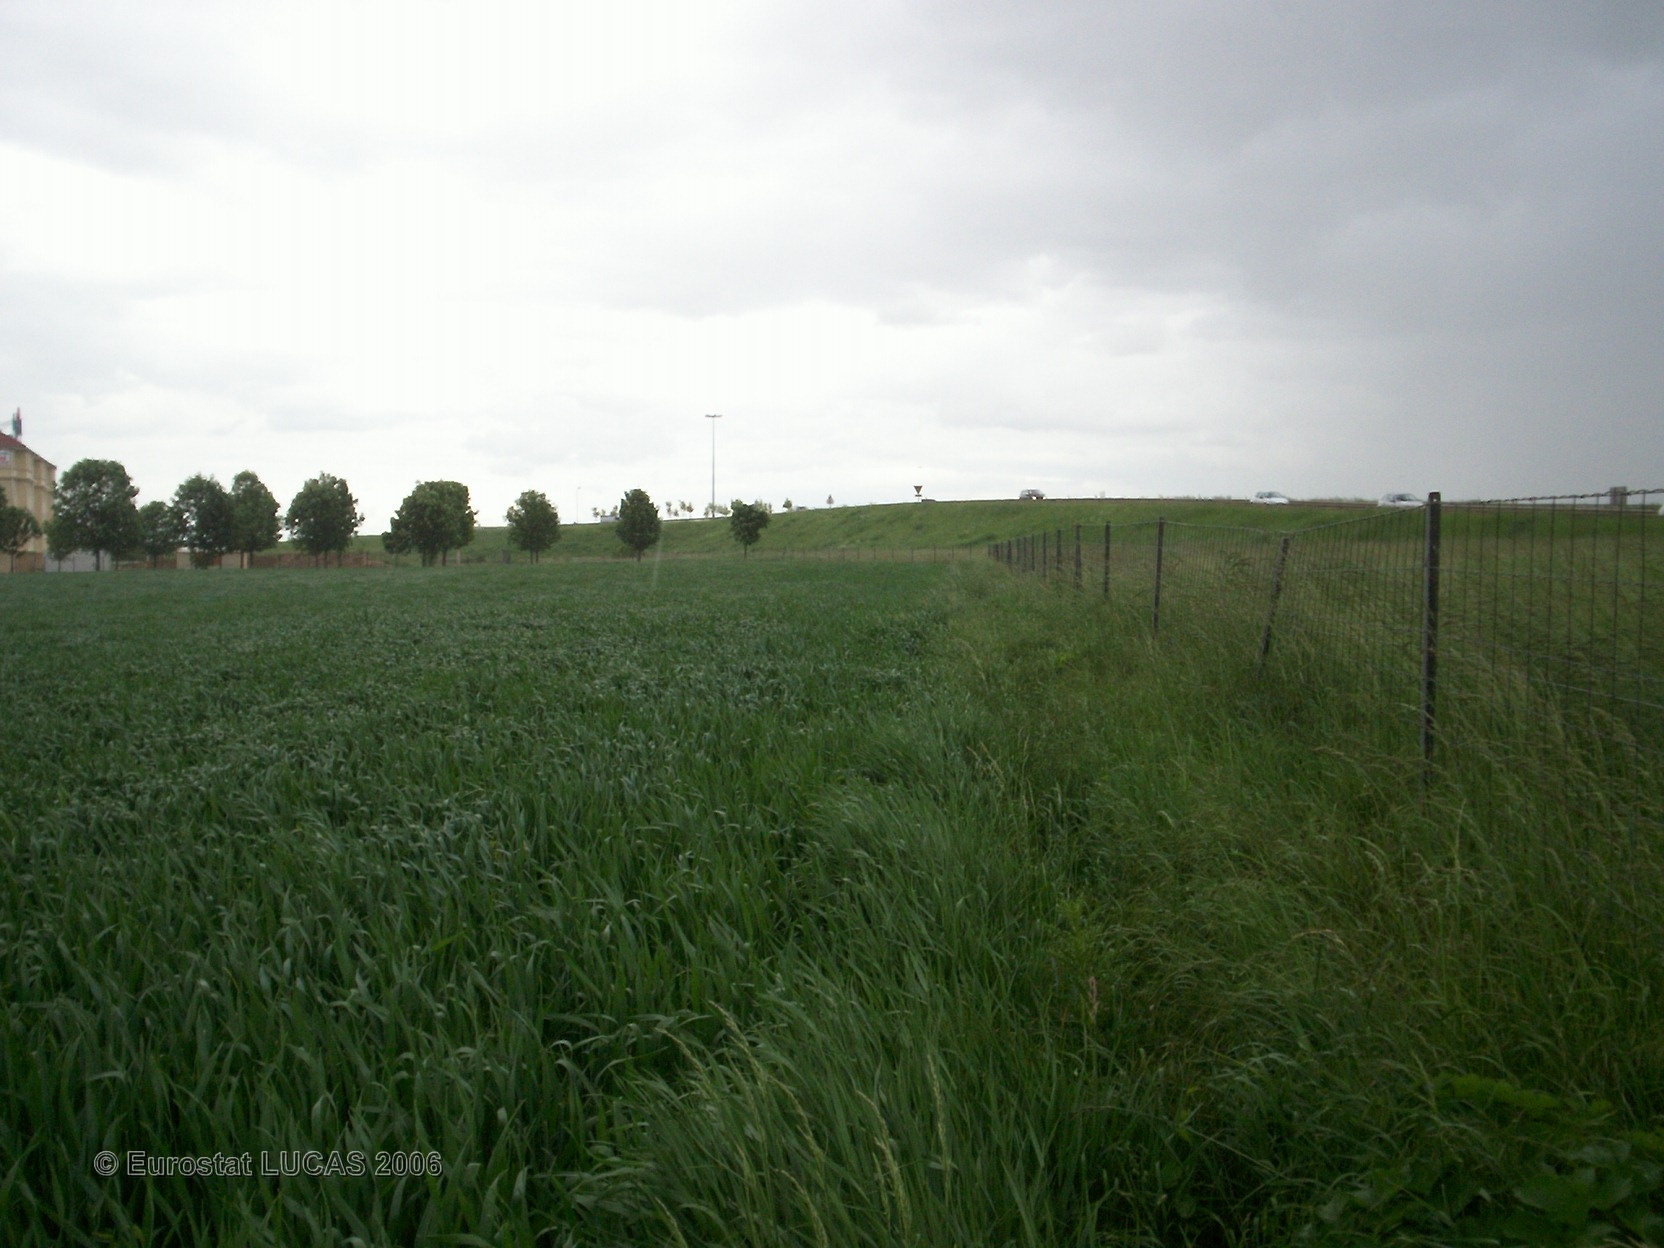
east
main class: Grassland
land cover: Grassland without tree/shrub cover
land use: Road transport
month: May
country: FR
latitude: 48.8305
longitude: 2.7018
